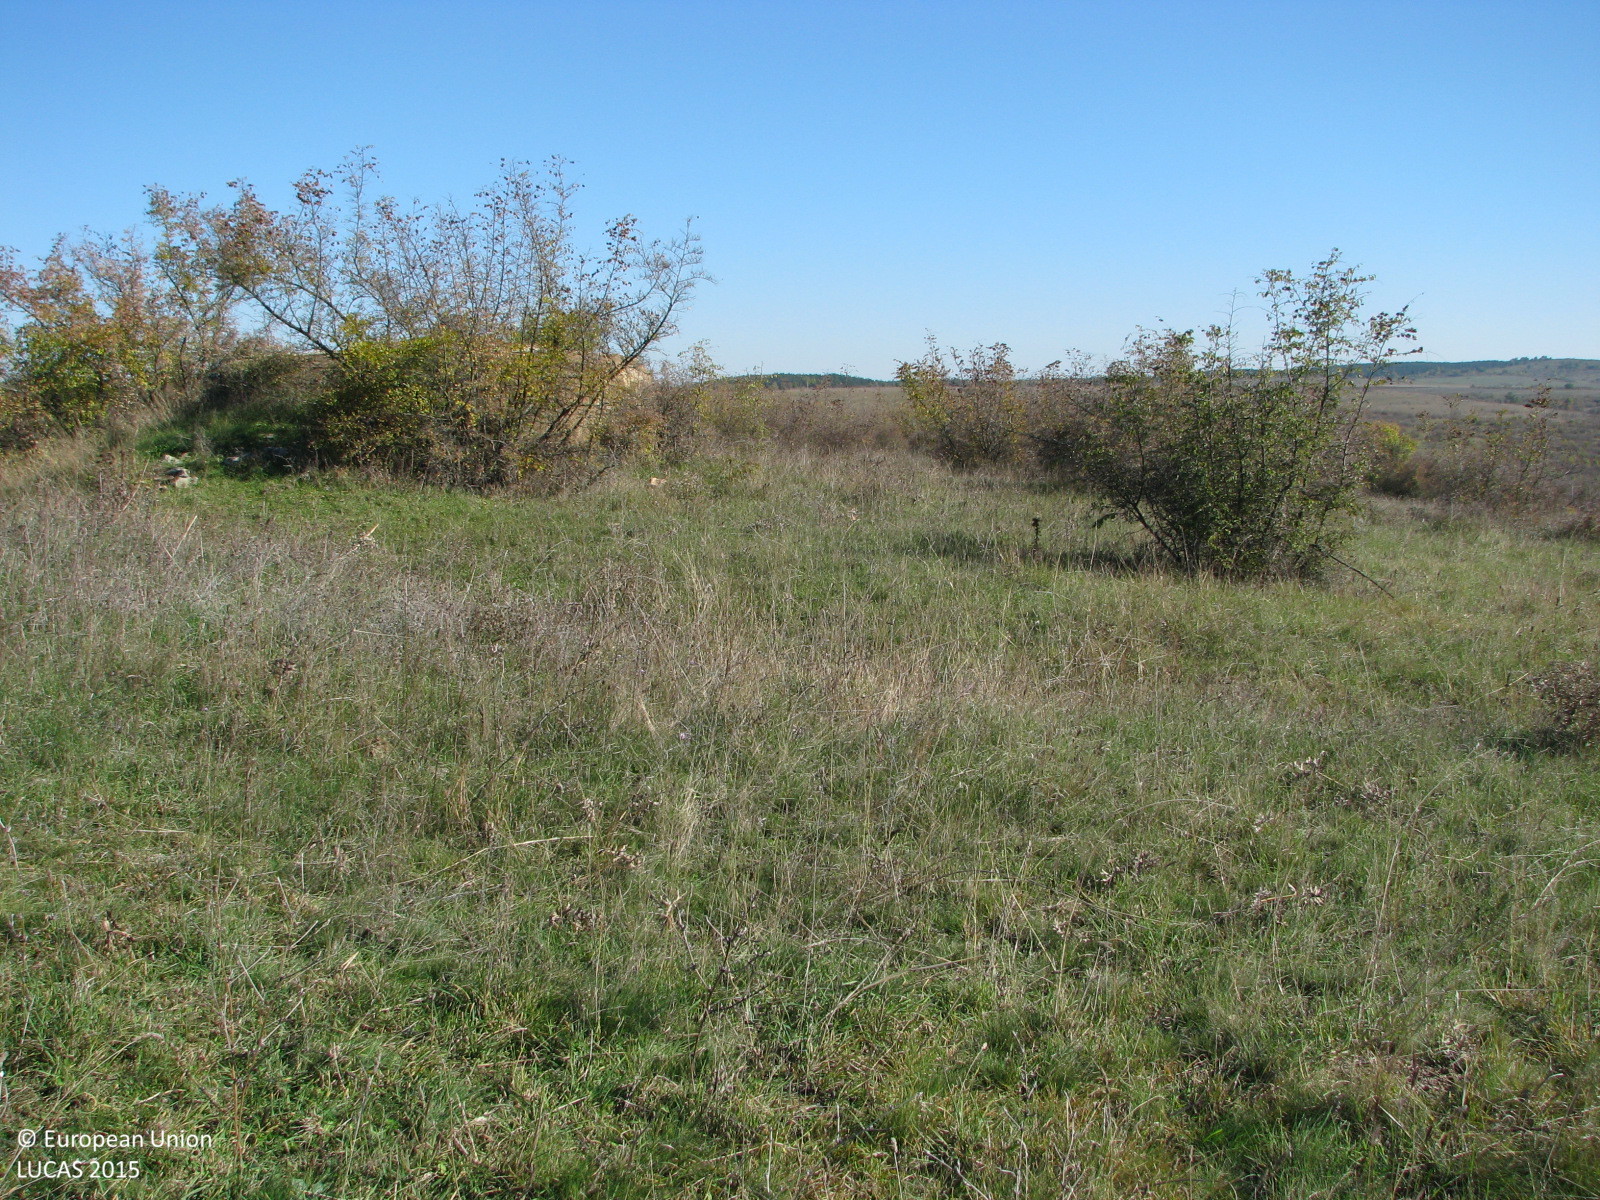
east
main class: Grassland
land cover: Grassland without tree/shrub cover
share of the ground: > 75 %
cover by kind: herbaceous plants 95 %, shrubs 5 %
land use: Agriculture (excluding fallow land and kitchen gardens)
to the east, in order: Grassland without tree/shrub cover; Shrubland without tree cover; Tracks; Grassland without tree/shrub cover; Shrubland without tree cover
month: November
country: BG
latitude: 42.0723
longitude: 26.6611
